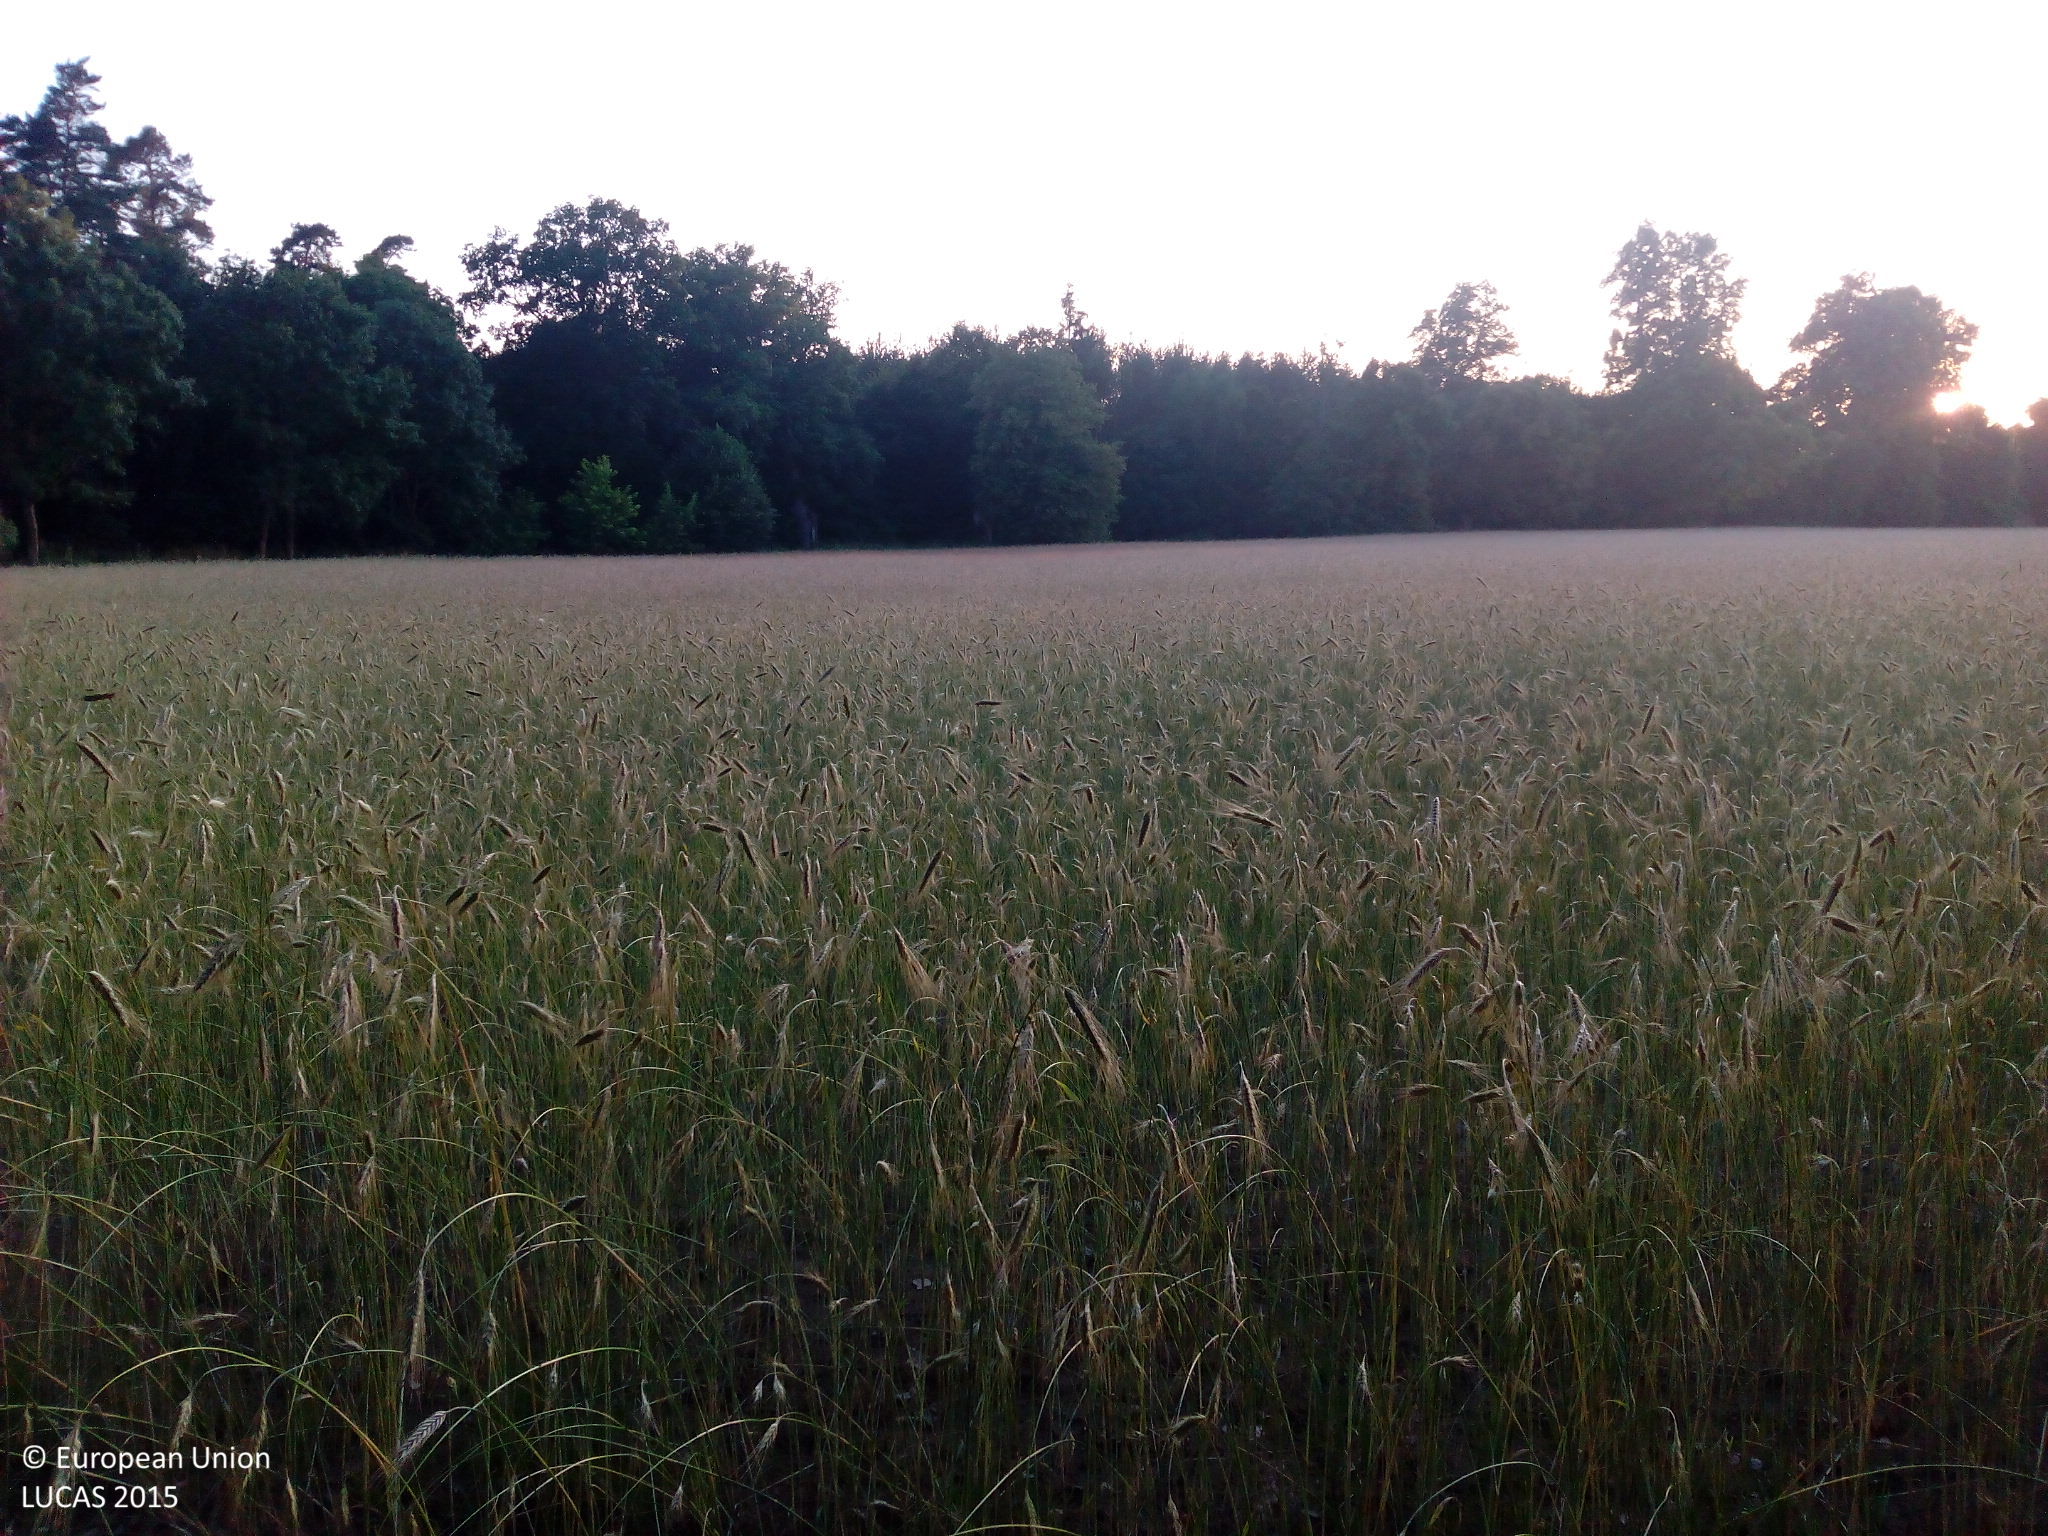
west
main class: Cropland
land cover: Rye
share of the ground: 50 - 75 %
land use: Agriculture (excluding fallow land and kitchen gardens)
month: July
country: DE
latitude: 53.5089
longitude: 14.2075
